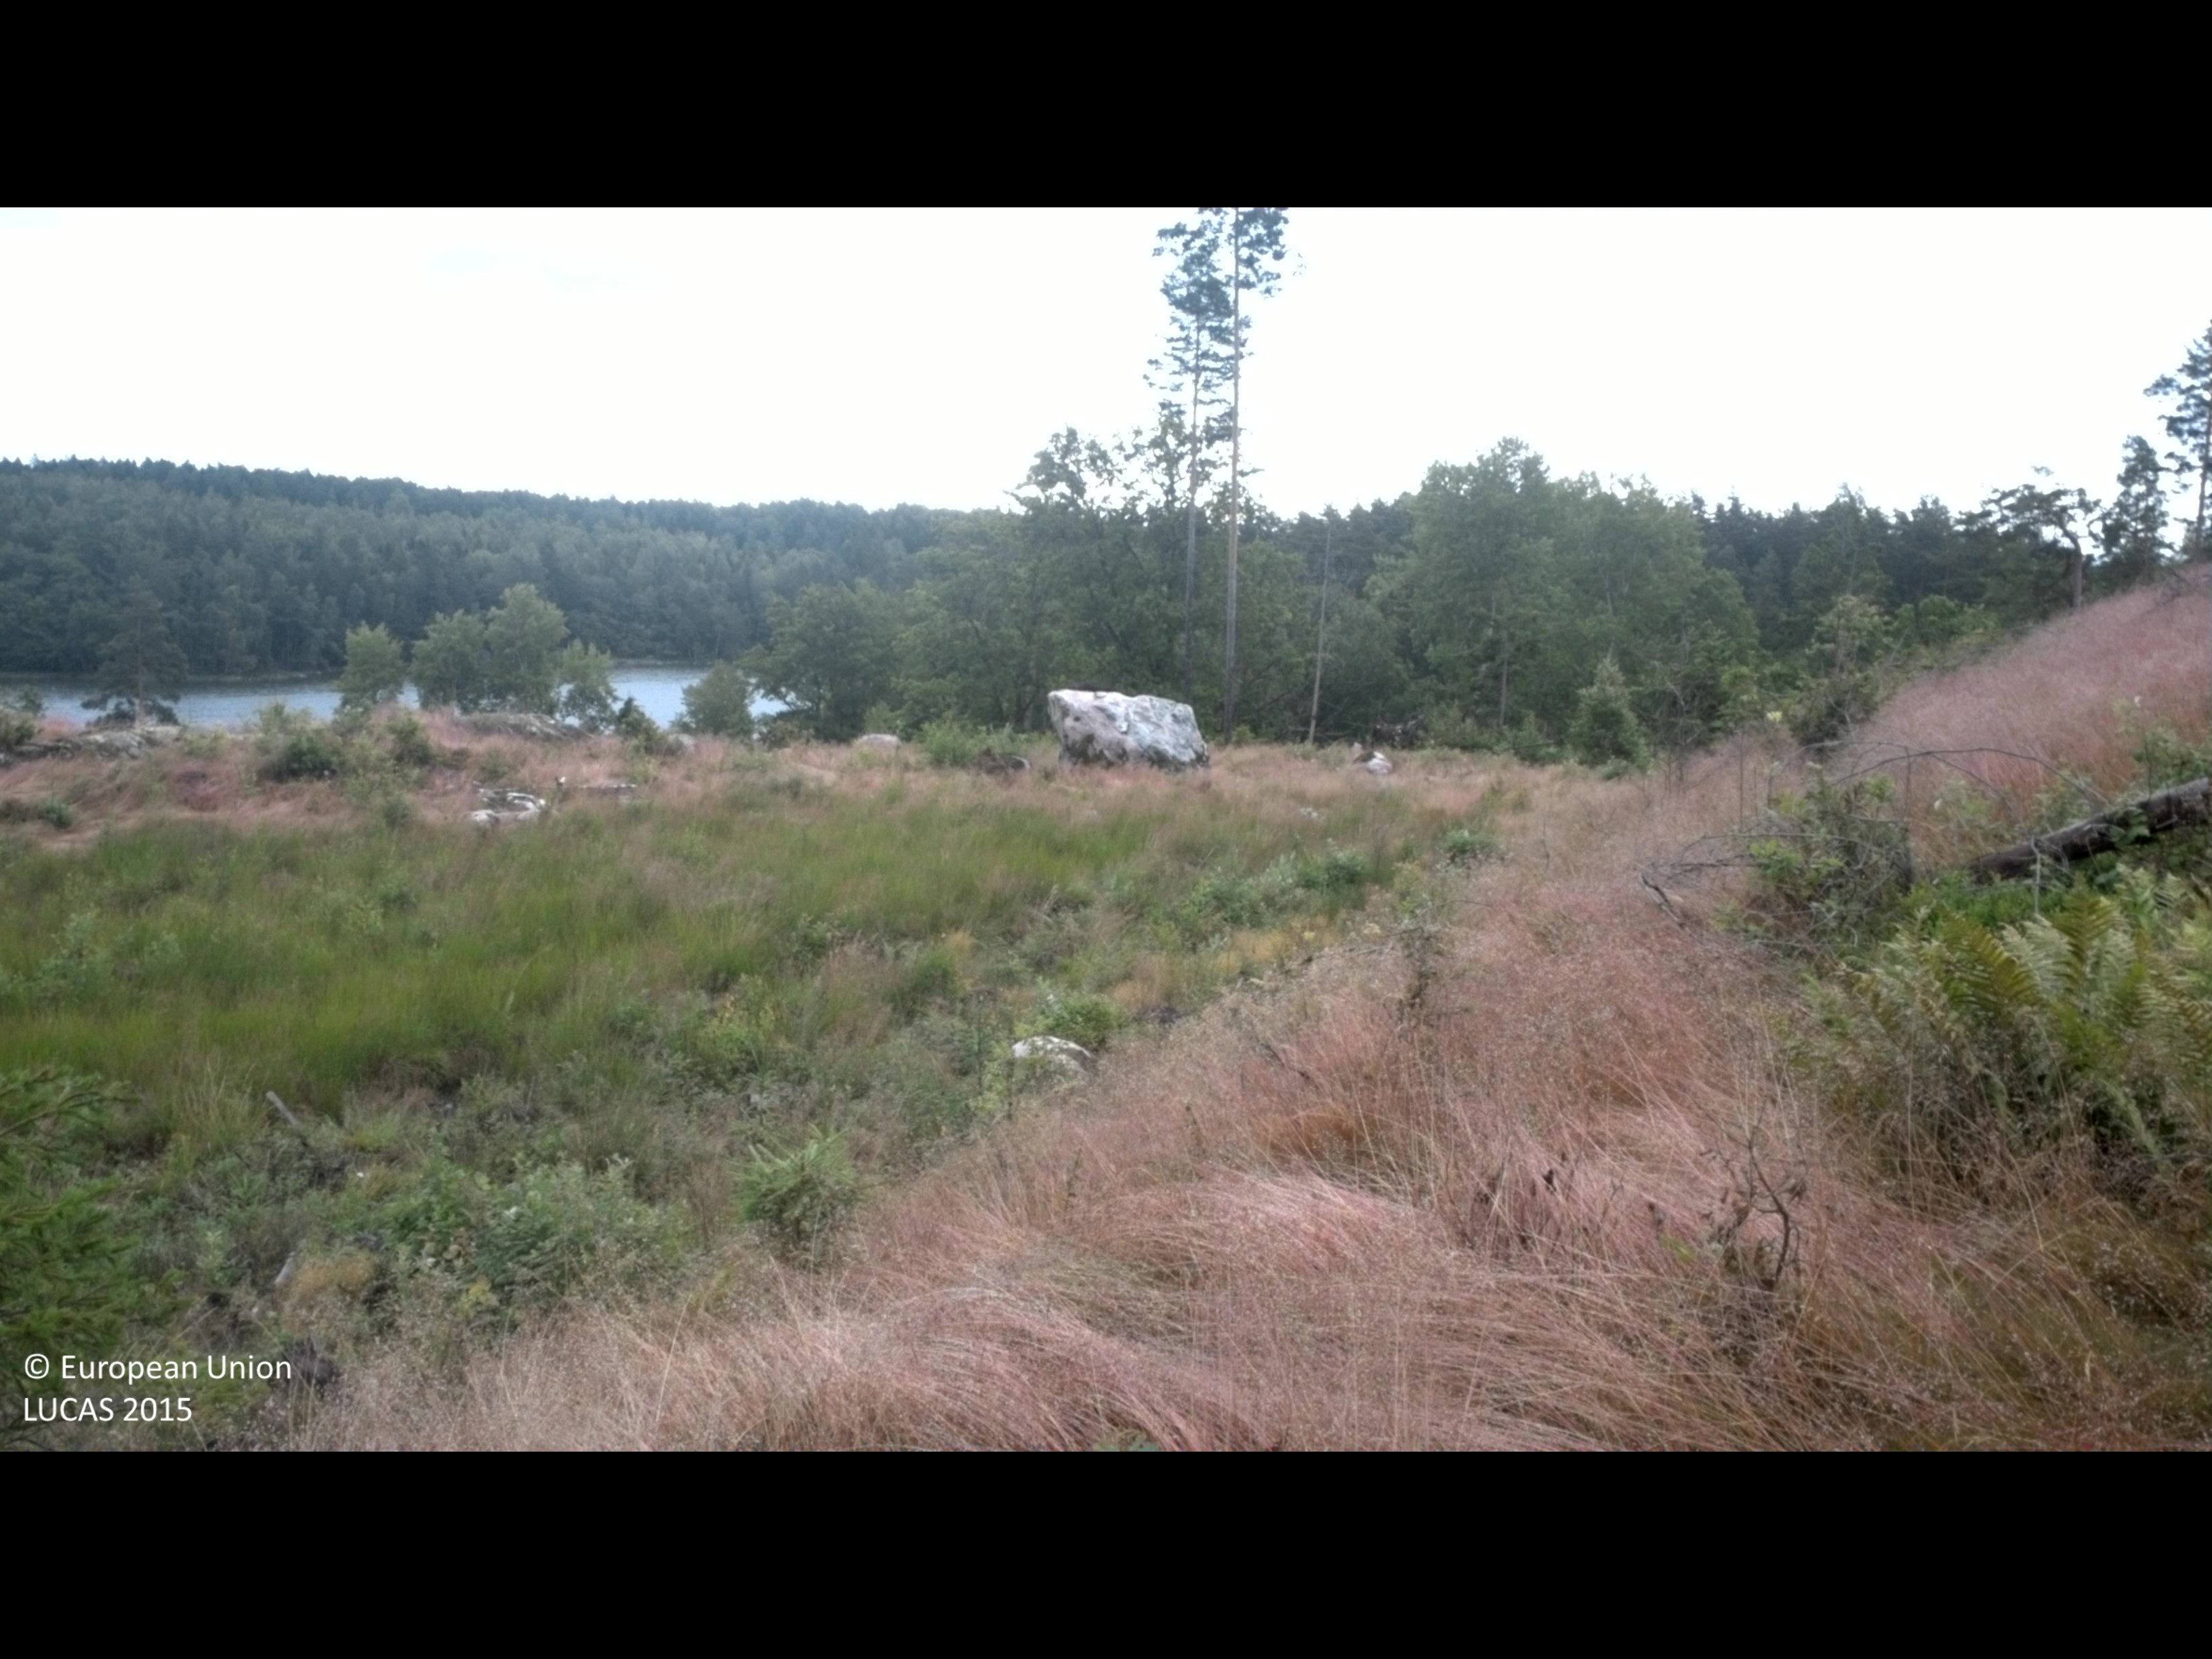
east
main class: Woodland
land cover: Other mixed woodland
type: boreal forest
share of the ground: 10 - 25 %
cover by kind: shrubs 45 %, herbaceous plants 40 %, broadleaved forest trees 10 %, coniferous forest trees 5 %
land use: Forestry
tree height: < 5 m
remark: Clear cut
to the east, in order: Other mixed woodland; Shrubland with sparse tree cover; Other mixed woodland; Rocks and stones; Broadleaved woodland; Ditches and canals; Paved roads, cycling and walking lanes; Shrubland with sparse tree cover; Broadleaved woodland; Inland fresh water bodies
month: July
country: SE
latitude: 58.3146
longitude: 16.1237
